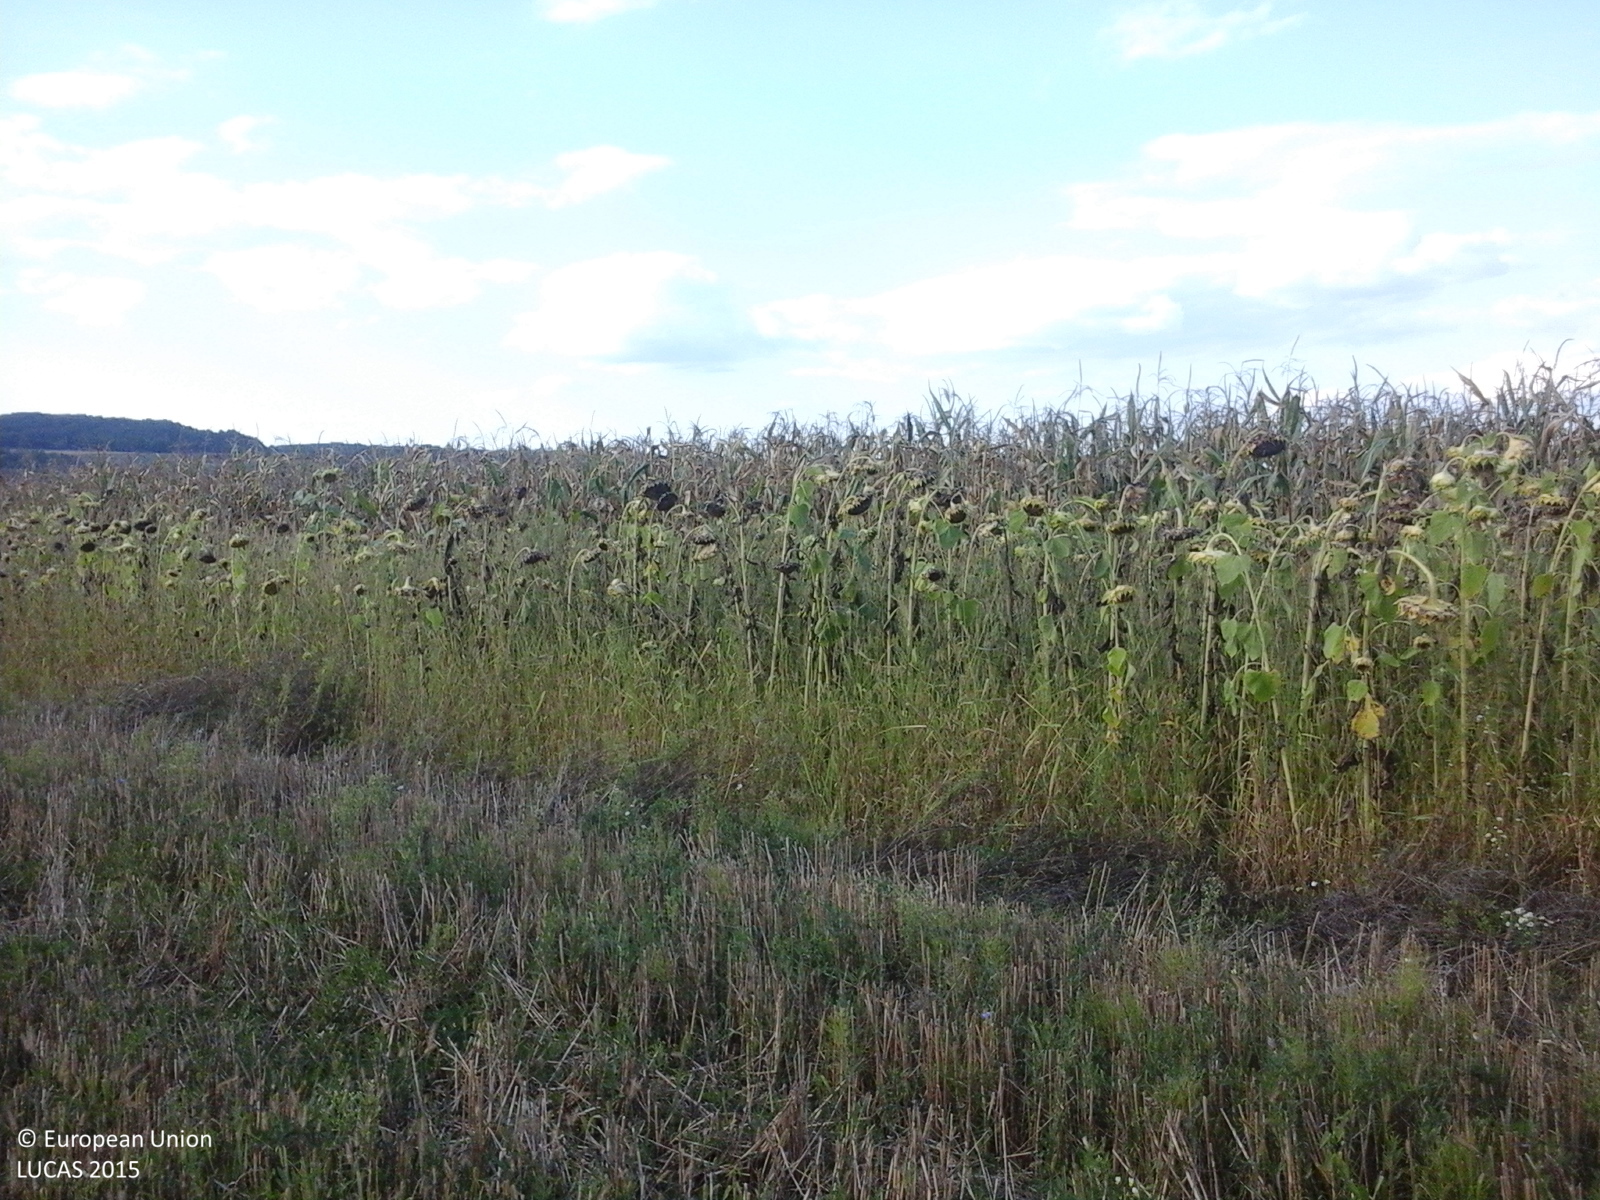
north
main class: Cropland
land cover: Common wheat
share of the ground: 50 - 75 %
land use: Agriculture (excluding fallow land and kitchen gardens)
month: September
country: RO
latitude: 47.5887
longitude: 23.3560
